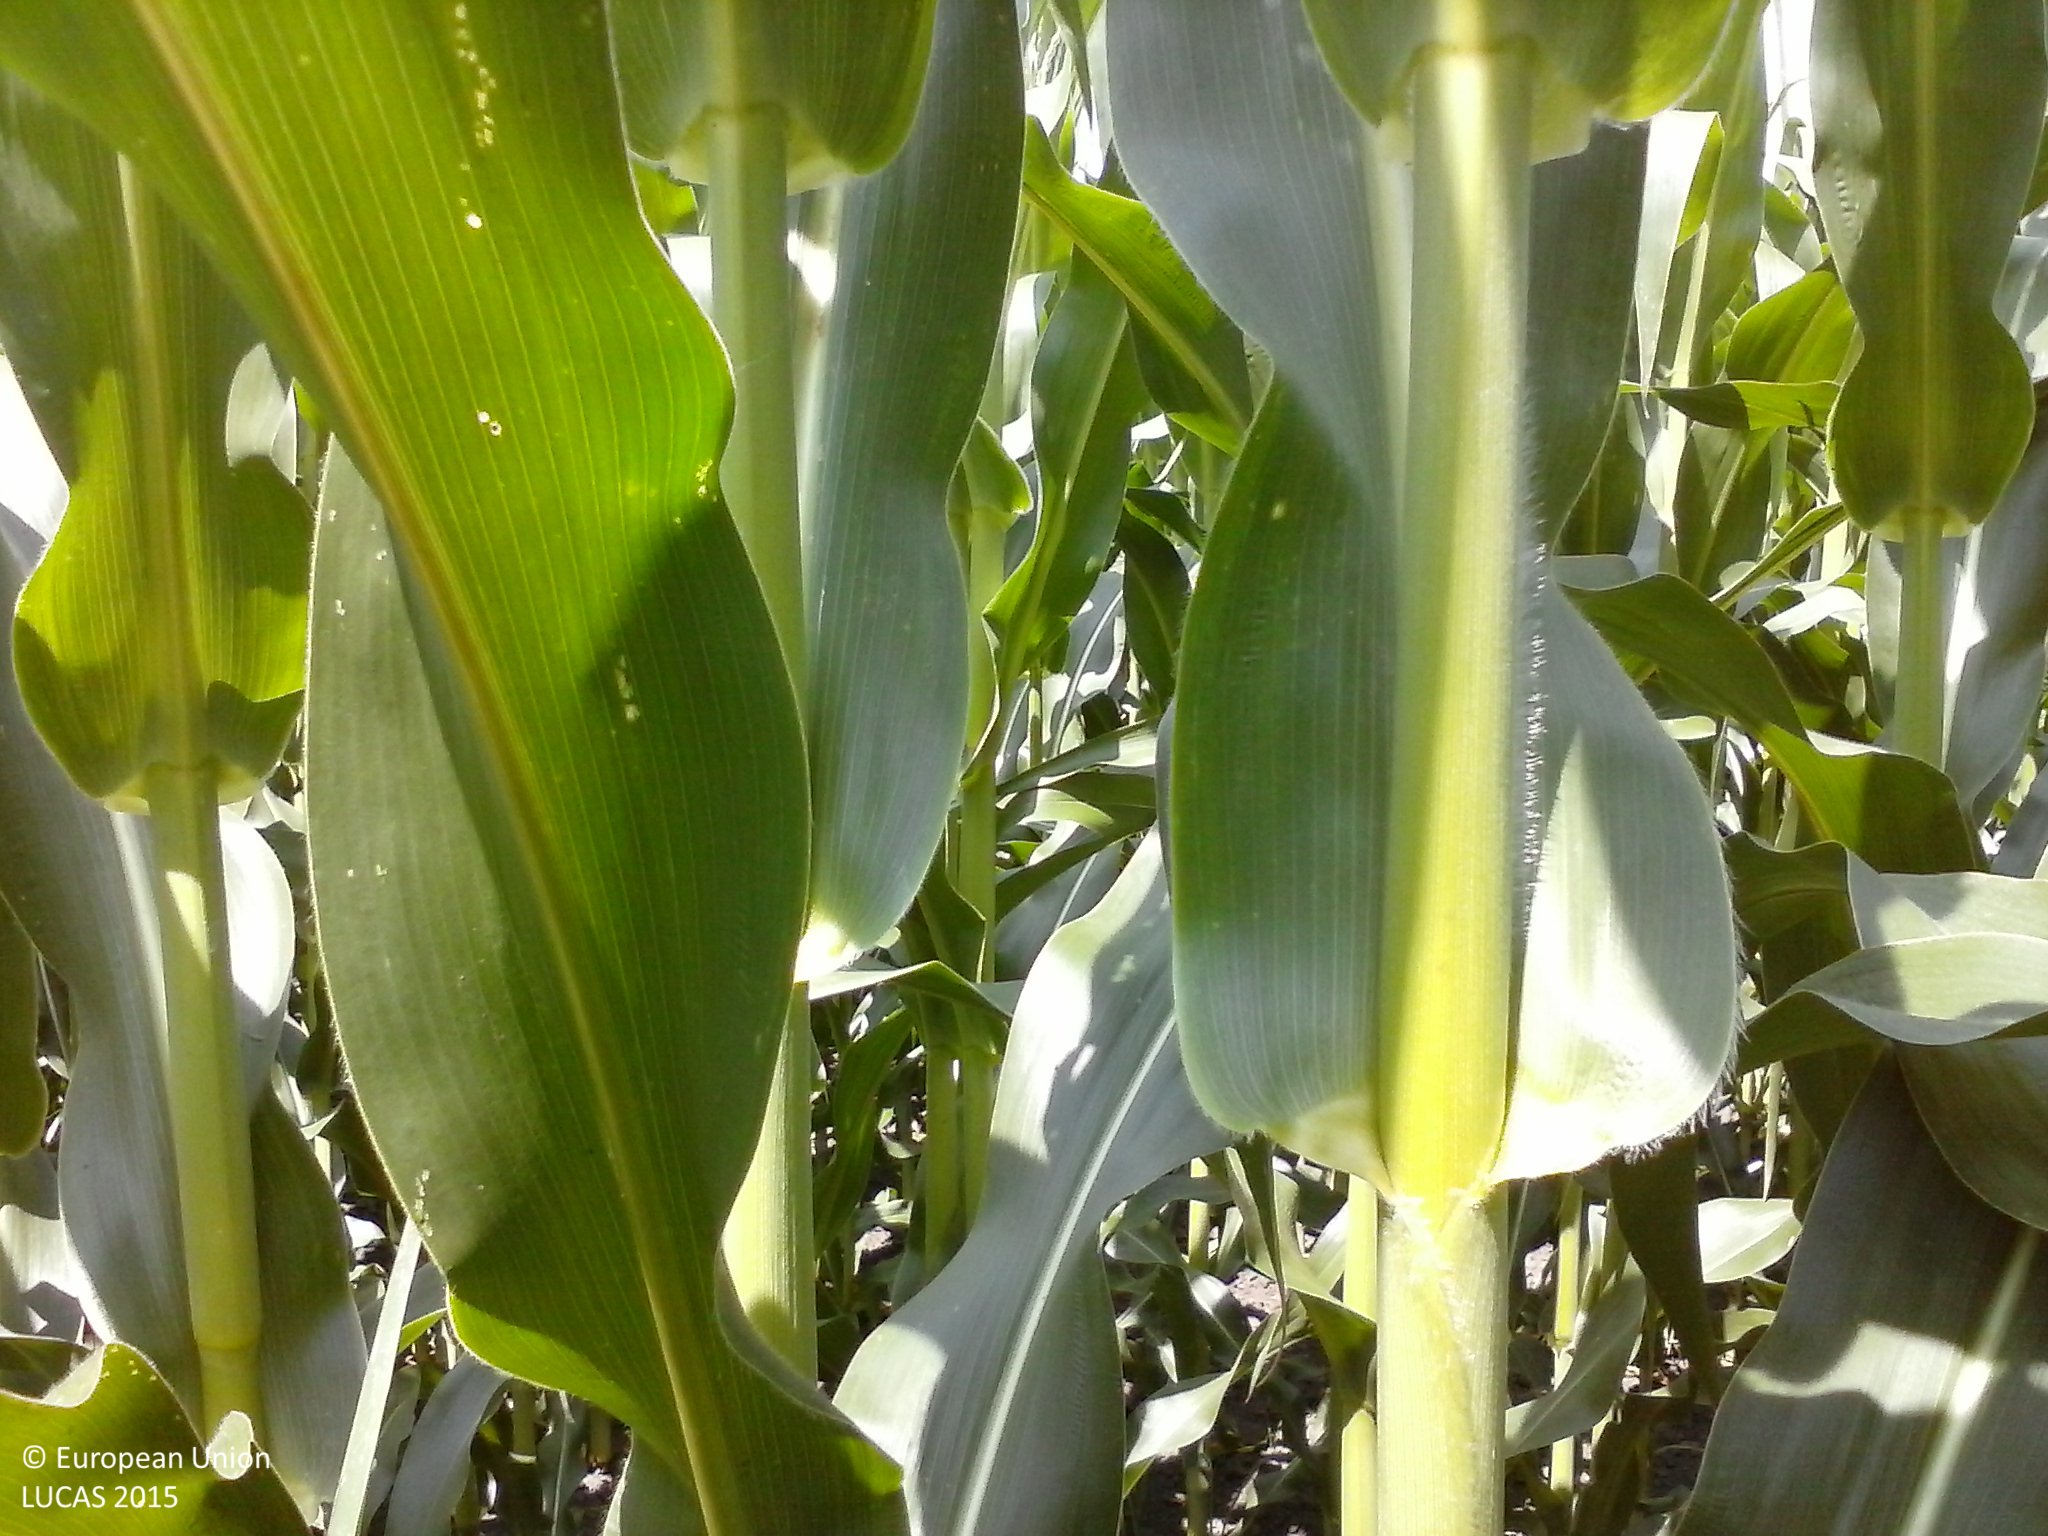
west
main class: Cropland
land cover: Maize
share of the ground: > 75 %
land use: Agriculture (excluding fallow land and kitchen gardens)
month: June
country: HU
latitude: 46.2183
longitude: 19.4925
